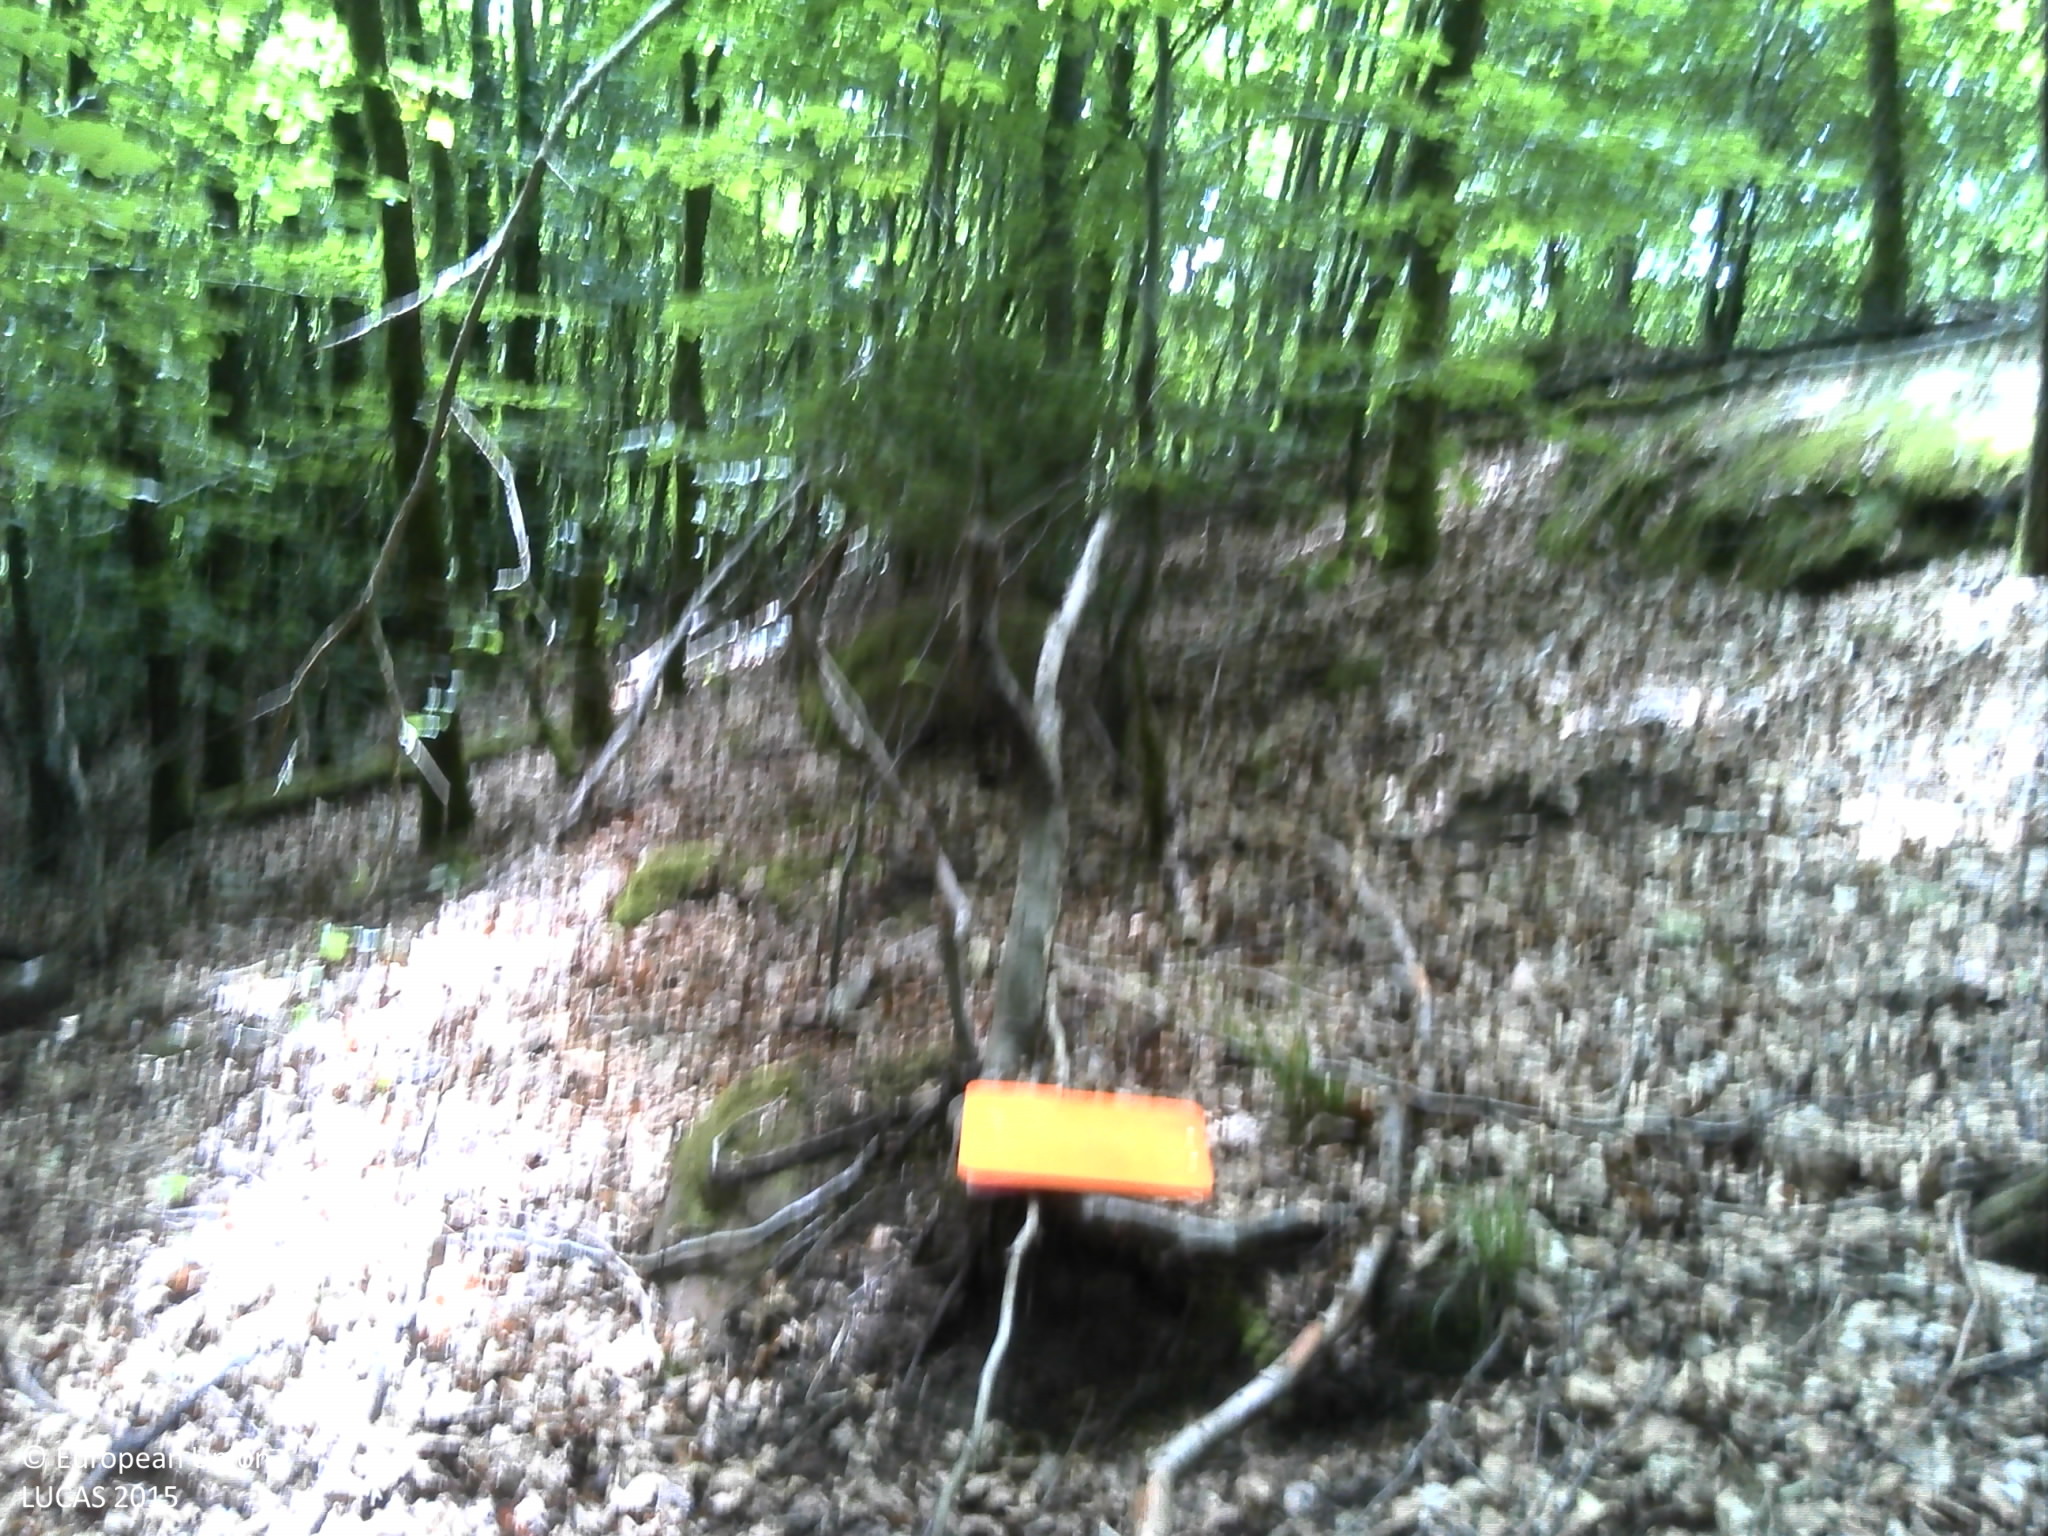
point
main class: Woodland
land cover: Broadleaved woodland
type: acidophilous oak and oak-birch forest
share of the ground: > 75 %
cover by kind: broadleaved forest trees 95 %, lichens and mosses 5 %
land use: Forestry
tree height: > 5 m
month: July
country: FR
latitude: 49.0040
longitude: 7.4443
